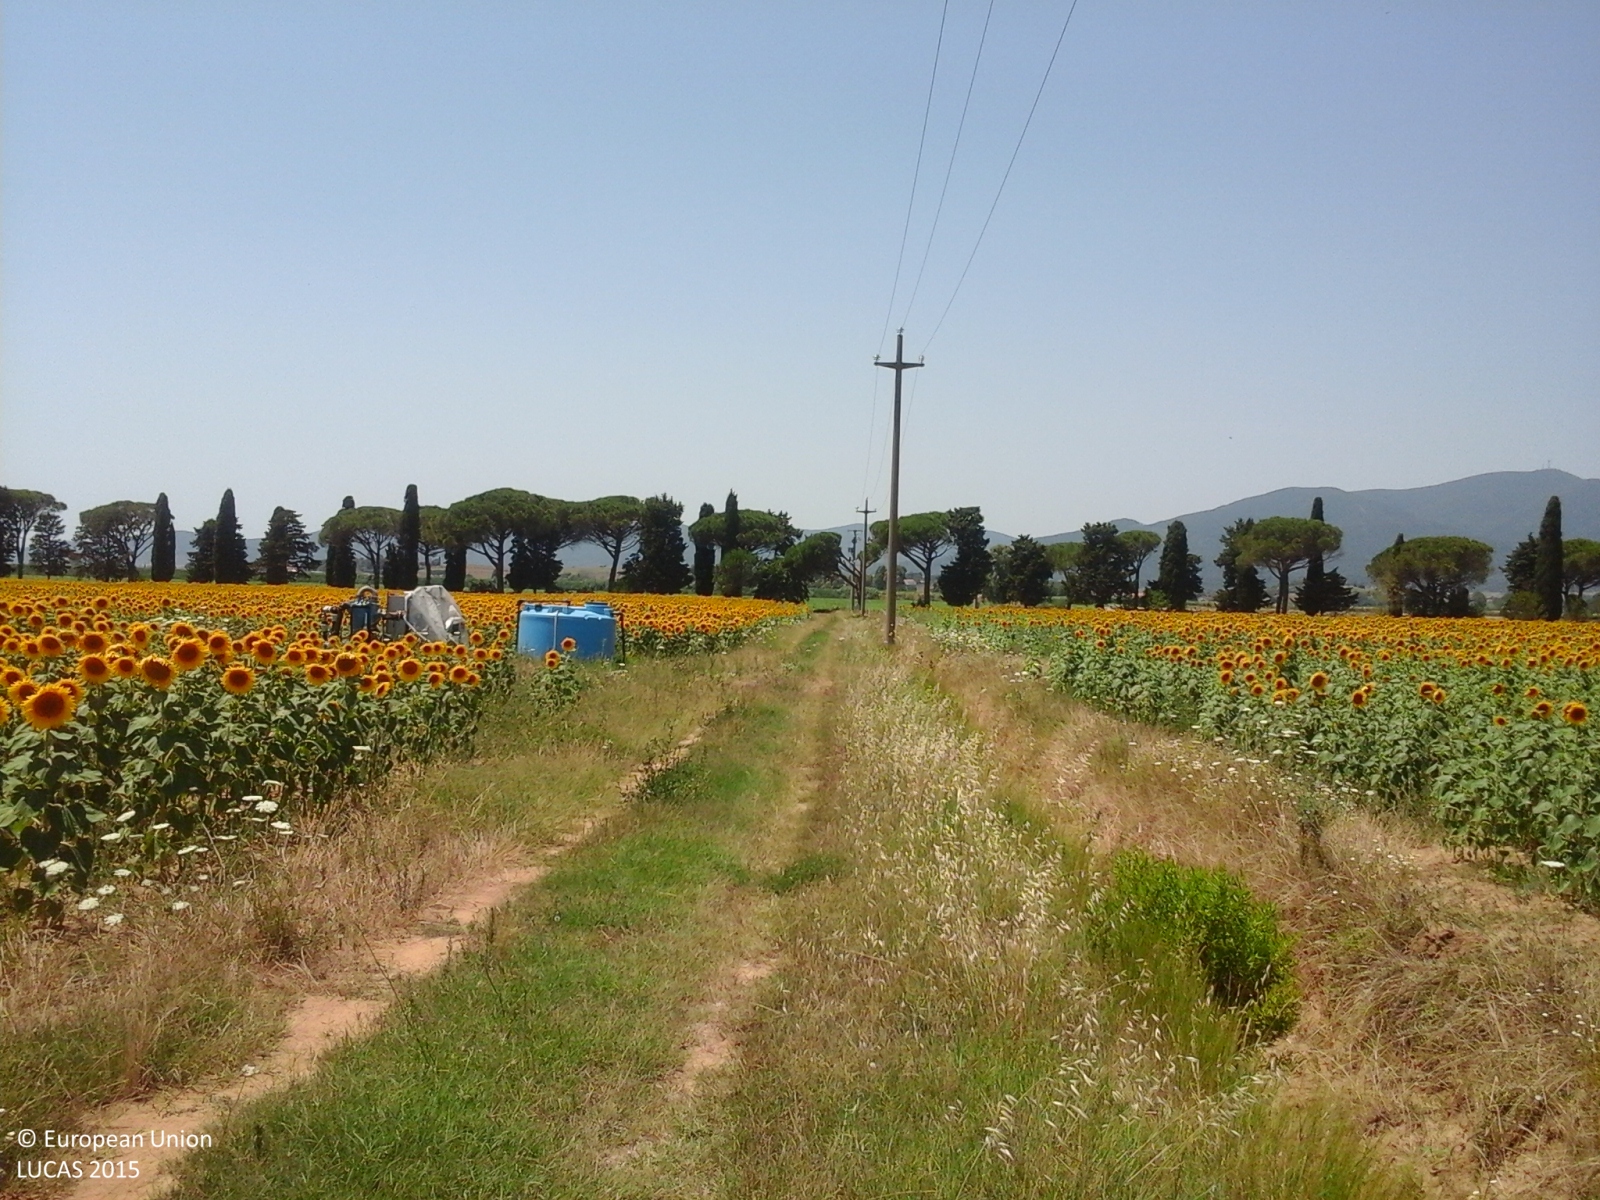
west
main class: Cropland
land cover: Sunflower
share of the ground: > 75 %
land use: Agriculture (excluding fallow land and kitchen gardens)
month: June
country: IT
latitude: 42.7939
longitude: 10.9627
